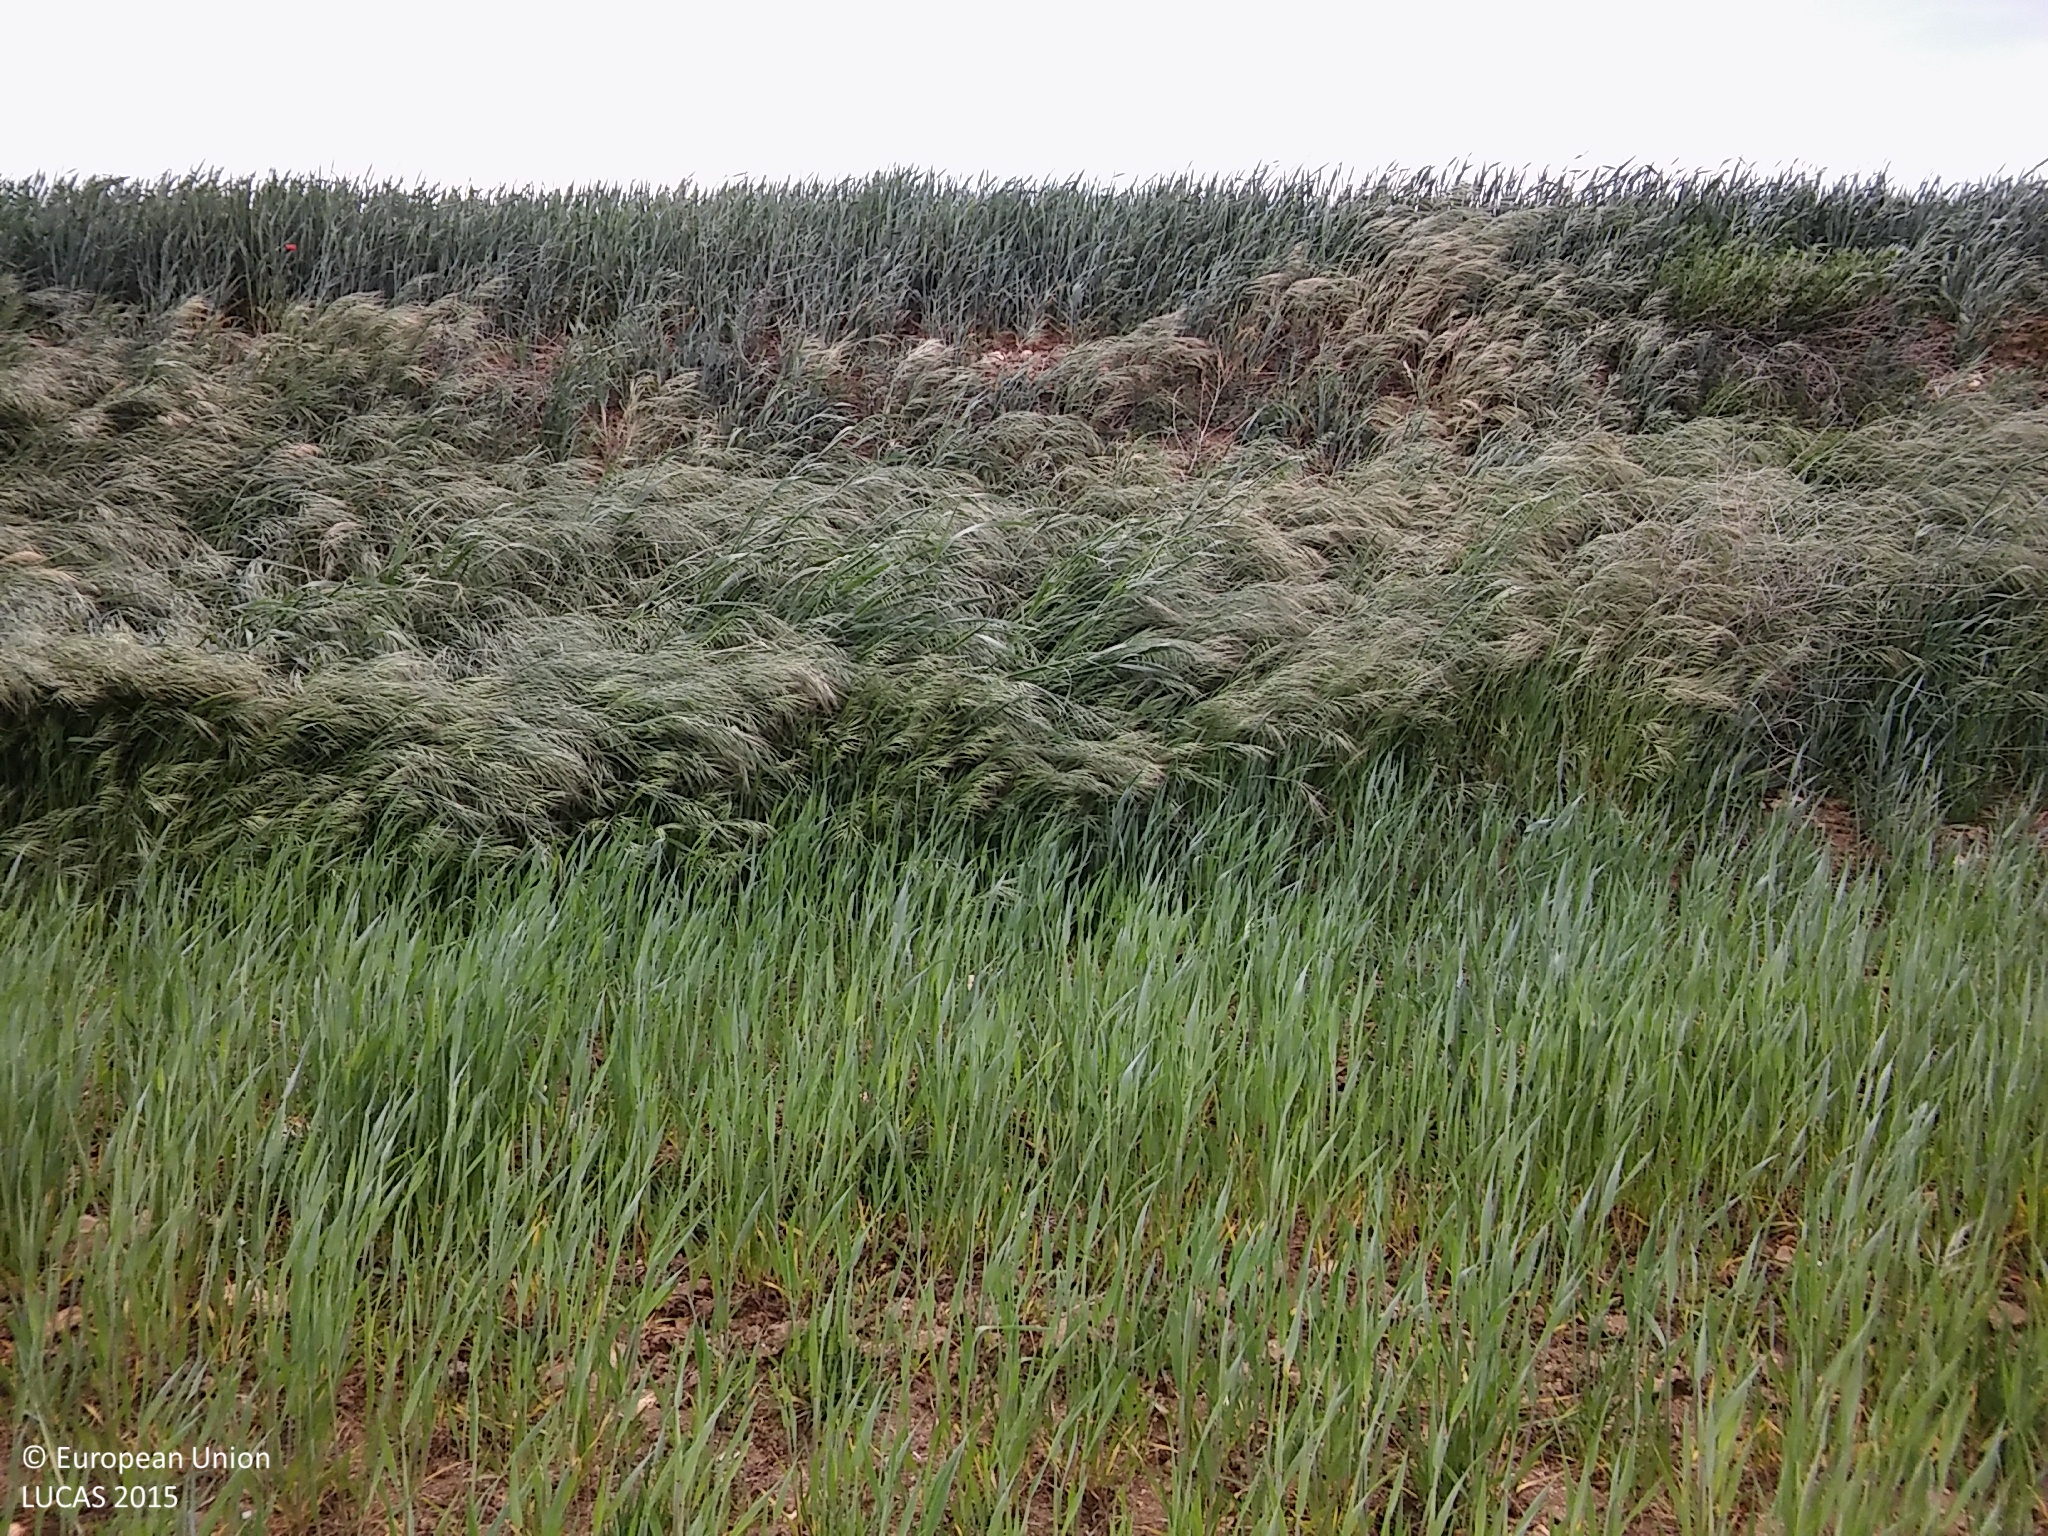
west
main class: Cropland
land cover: Common wheat
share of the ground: > 75 %
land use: Agriculture (excluding fallow land and kitchen gardens)
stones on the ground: < 10 %
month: May
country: ES
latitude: 41.1028
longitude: -4.0418
